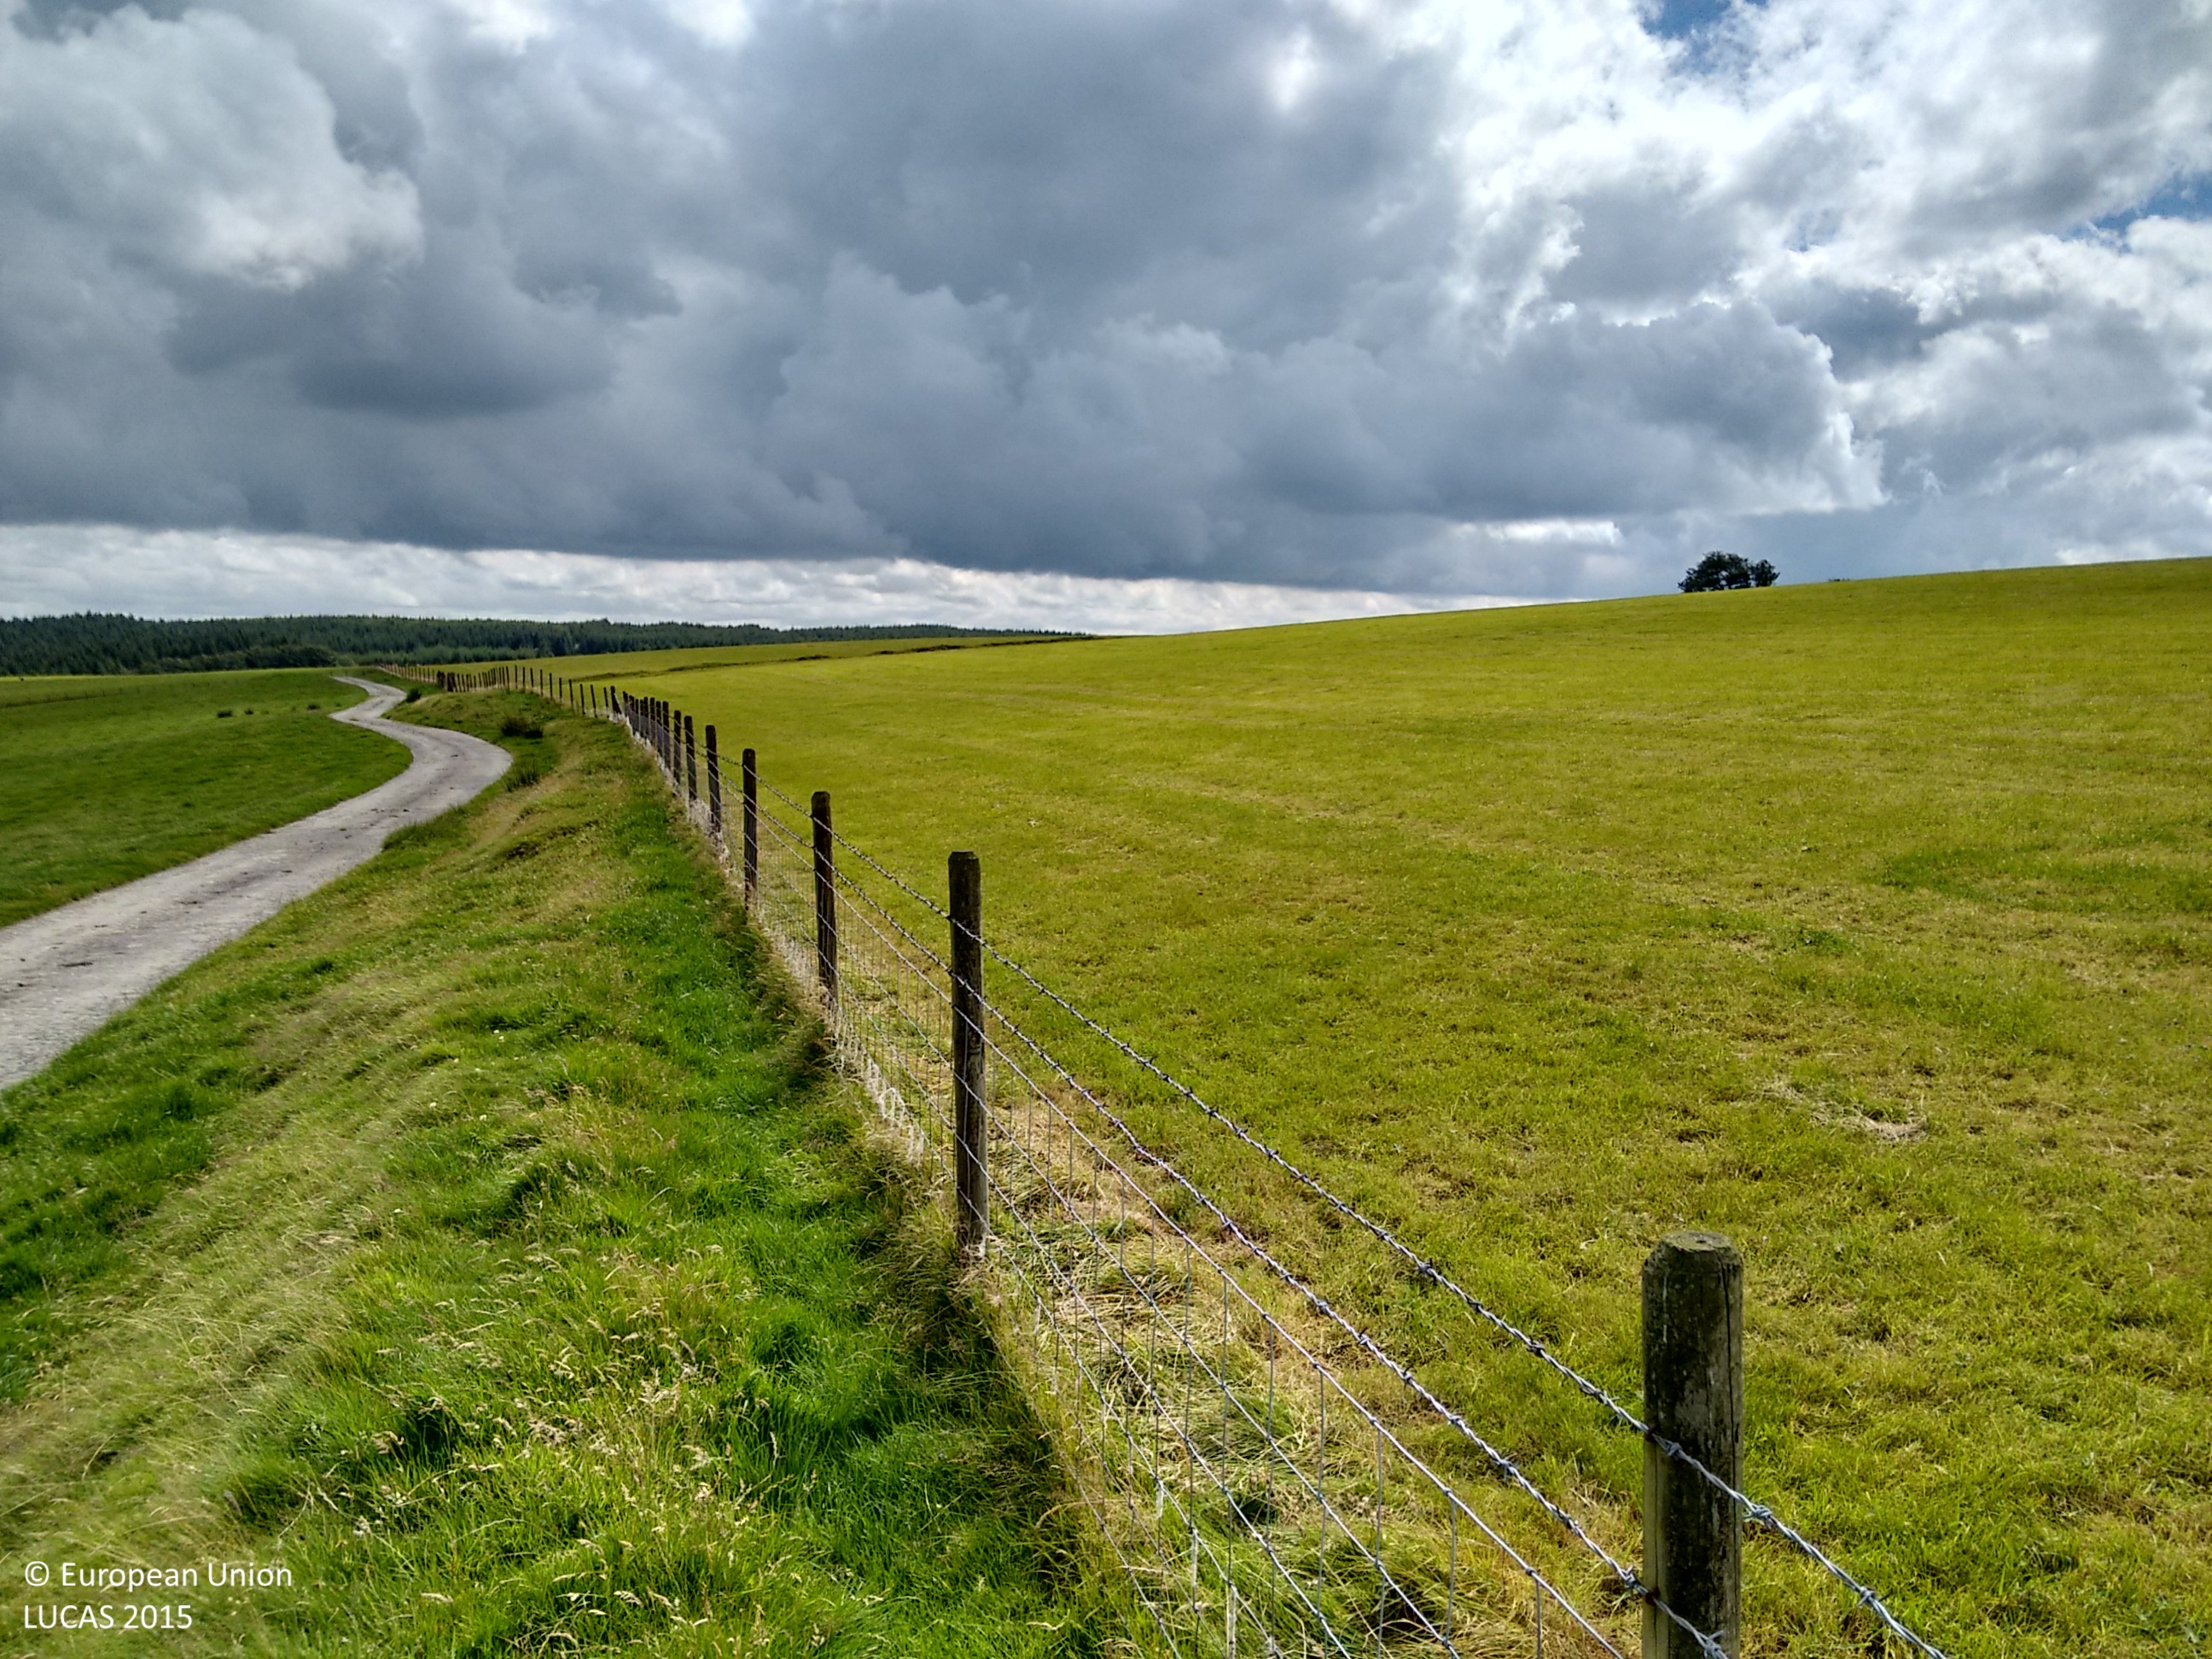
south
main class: Grassland
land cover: Grassland without tree/shrub cover
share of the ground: > 75 %
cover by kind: herbaceous plants 100 %
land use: Agriculture (excluding fallow land and kitchen gardens)
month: August
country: GB
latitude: 52.0055
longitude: -4.0961
